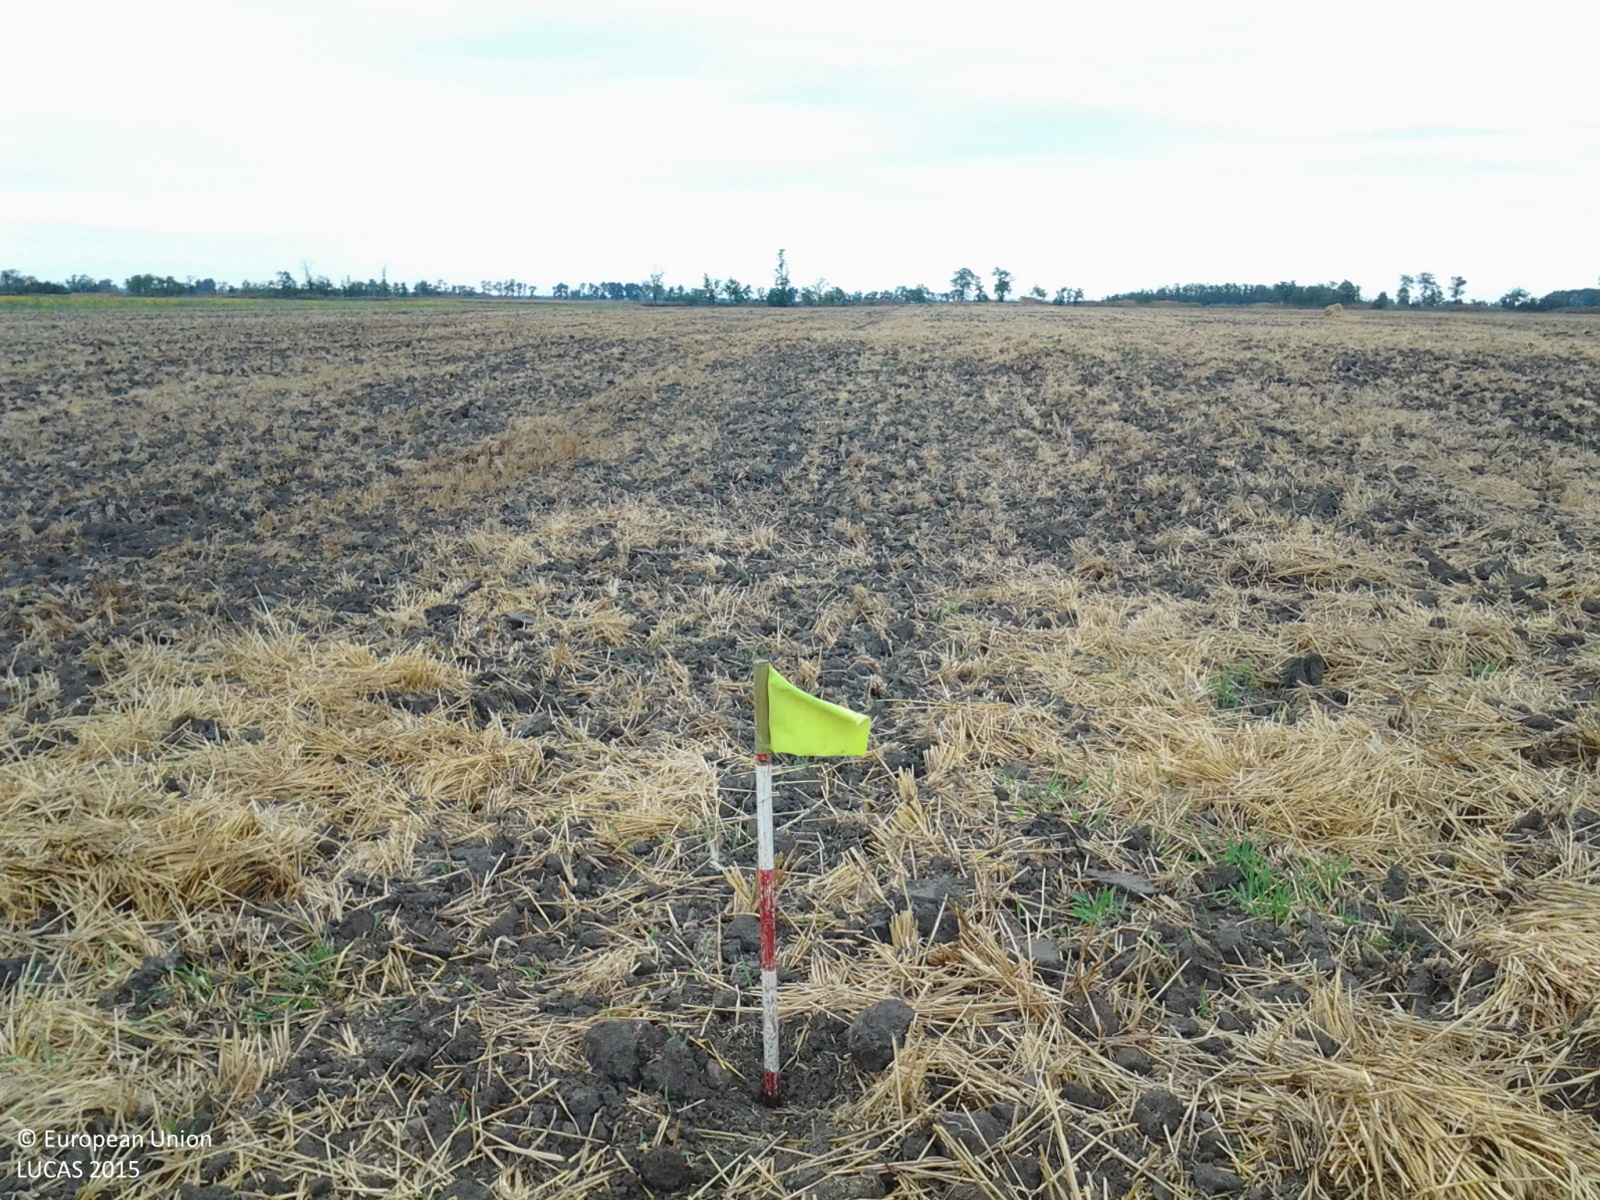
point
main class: Cropland
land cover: Barley
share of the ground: < 10 %
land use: Agriculture (excluding fallow land and kitchen gardens)
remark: Harvested field
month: July
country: HU
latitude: 47.1719
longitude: 20.5452
